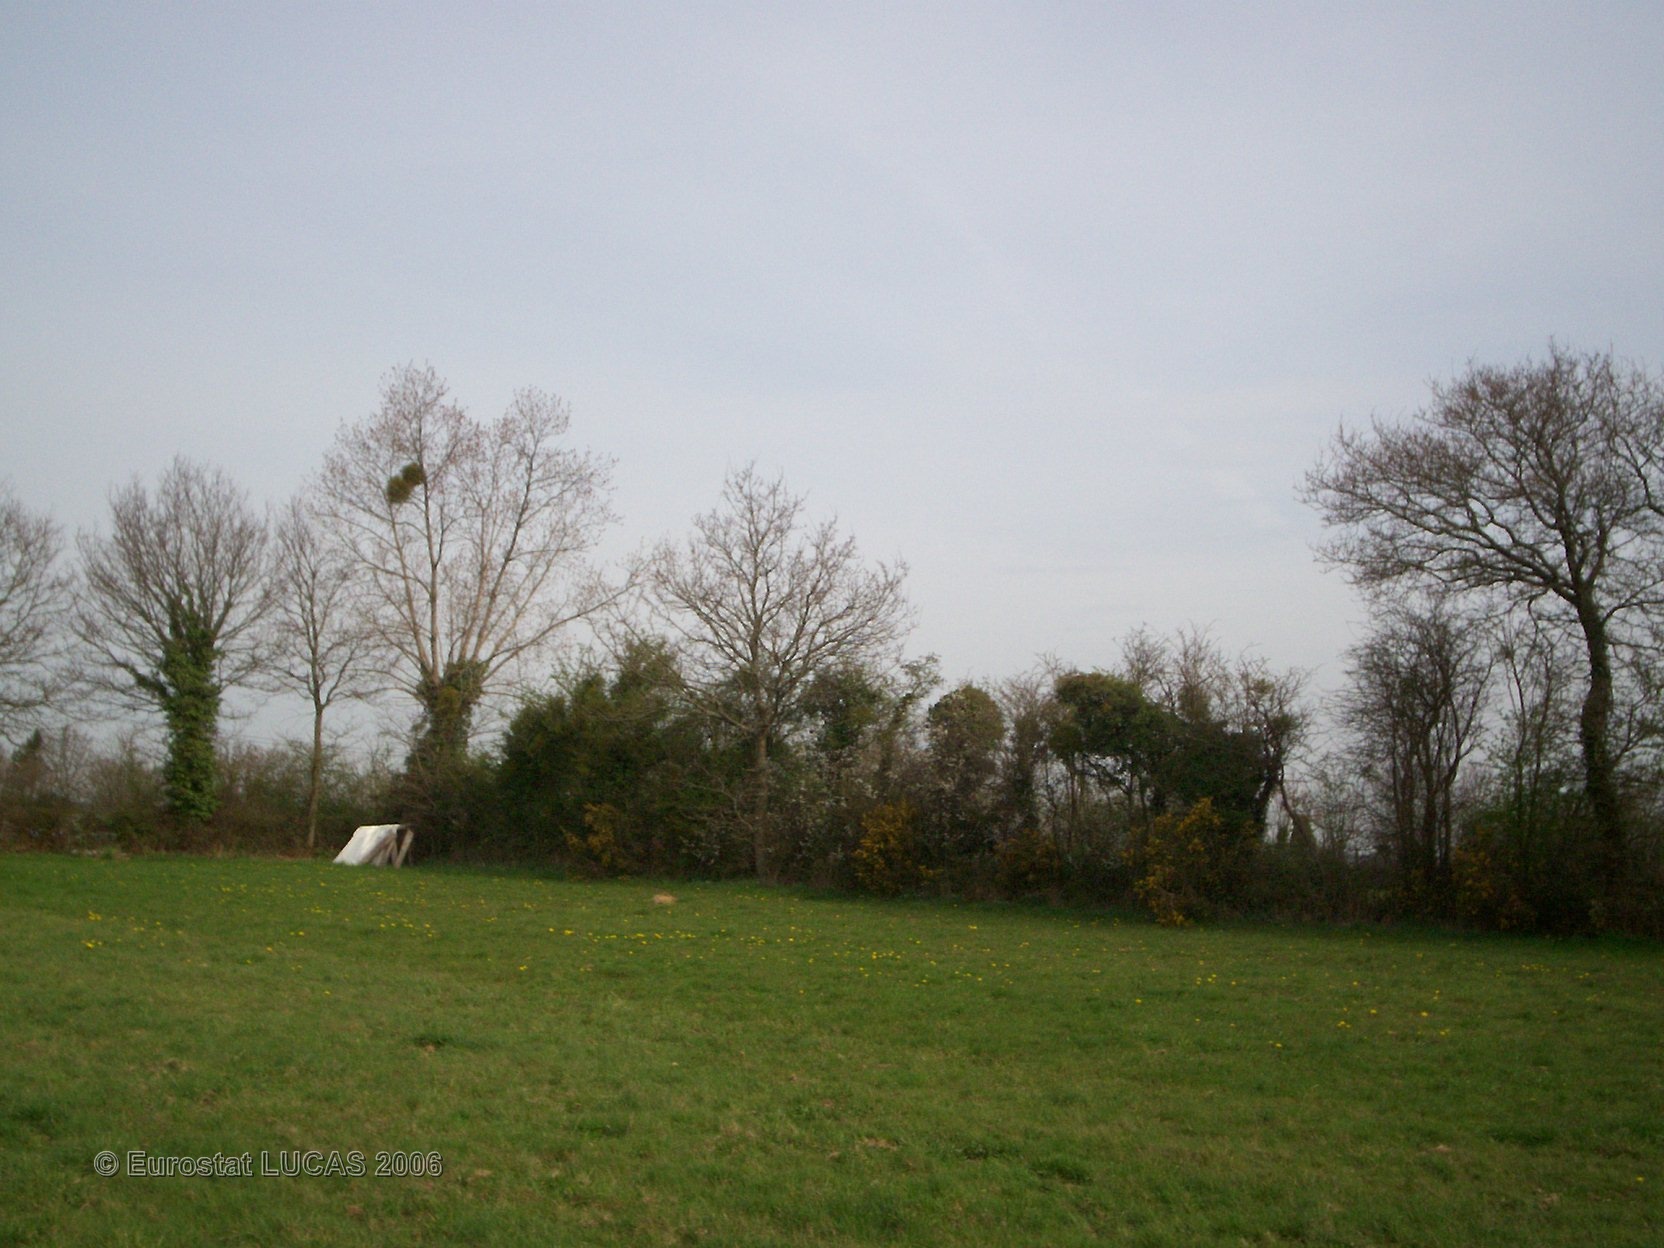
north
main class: Grassland
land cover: Grassland without tree/shrub cover
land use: Agriculture (excluding fallow land and kitchen gardens)
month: April
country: FR
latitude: 49.3648
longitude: -1.4919
